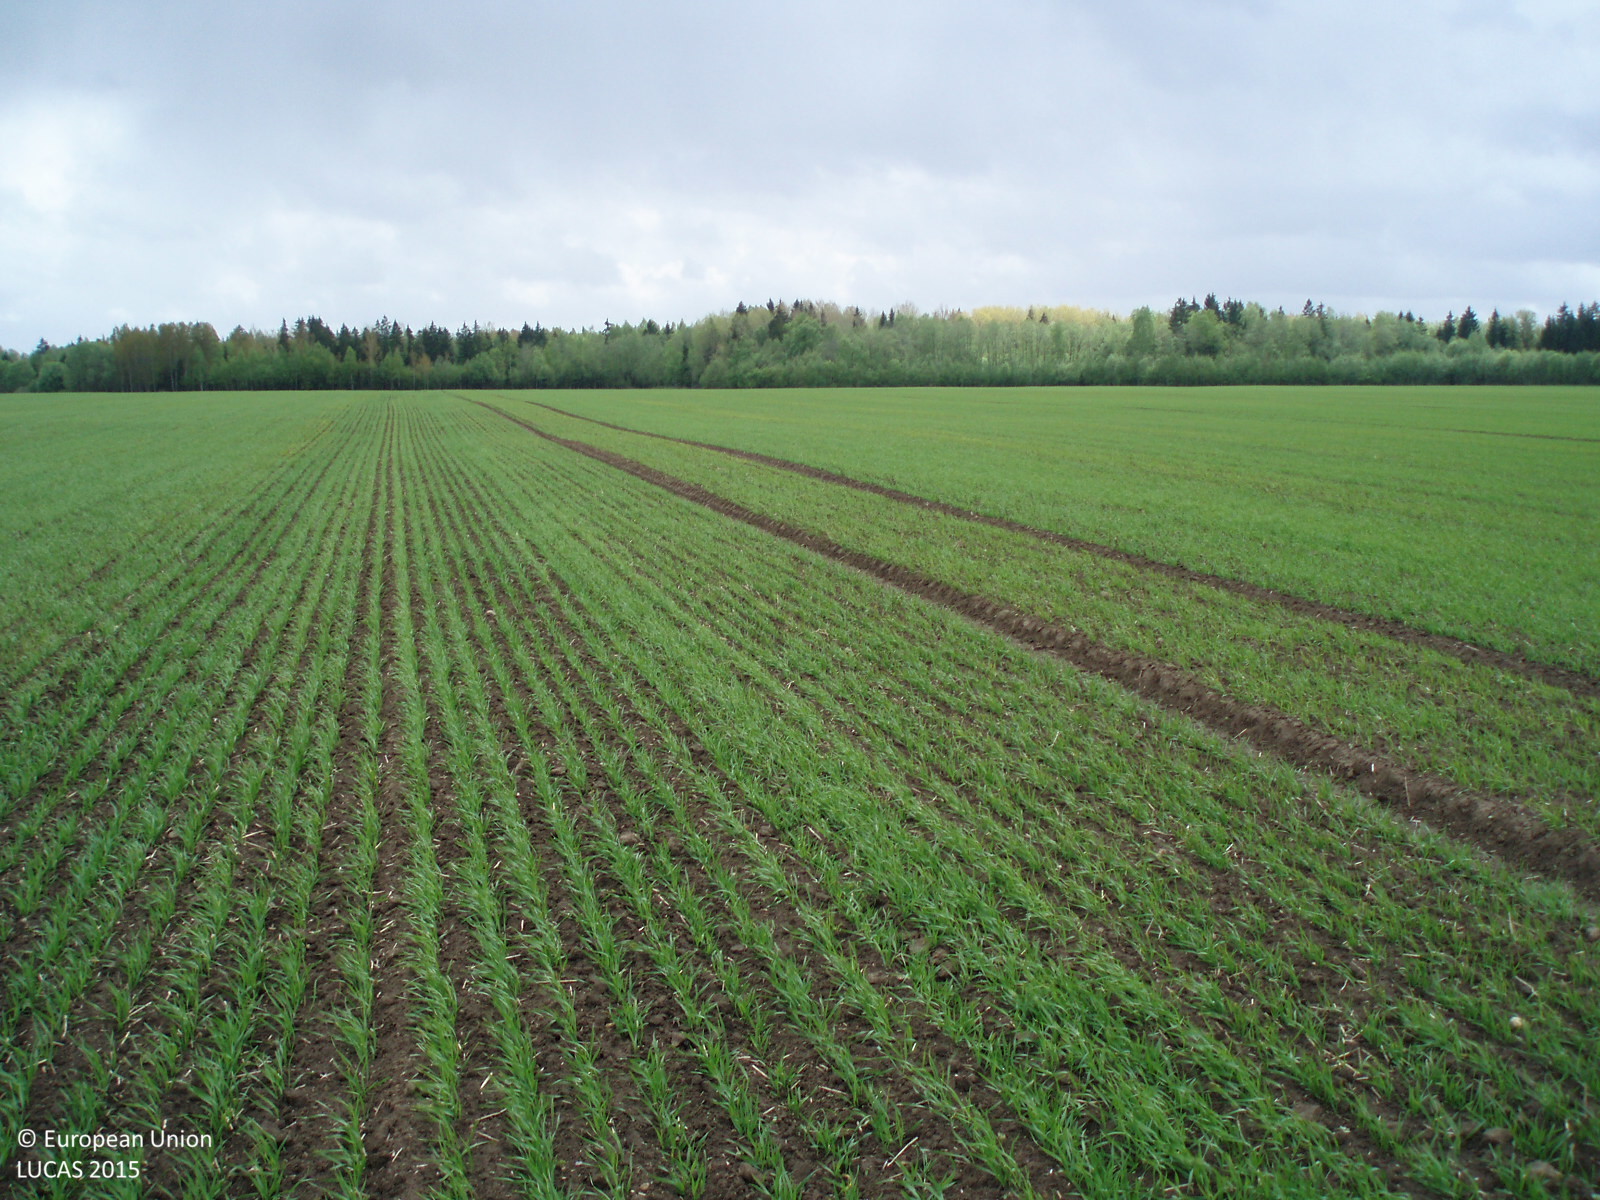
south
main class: Cropland
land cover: Common wheat
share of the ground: 50 - 75 %
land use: Agriculture (excluding fallow land and kitchen gardens)
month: May
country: LT
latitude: 56.3699
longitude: 22.7385
